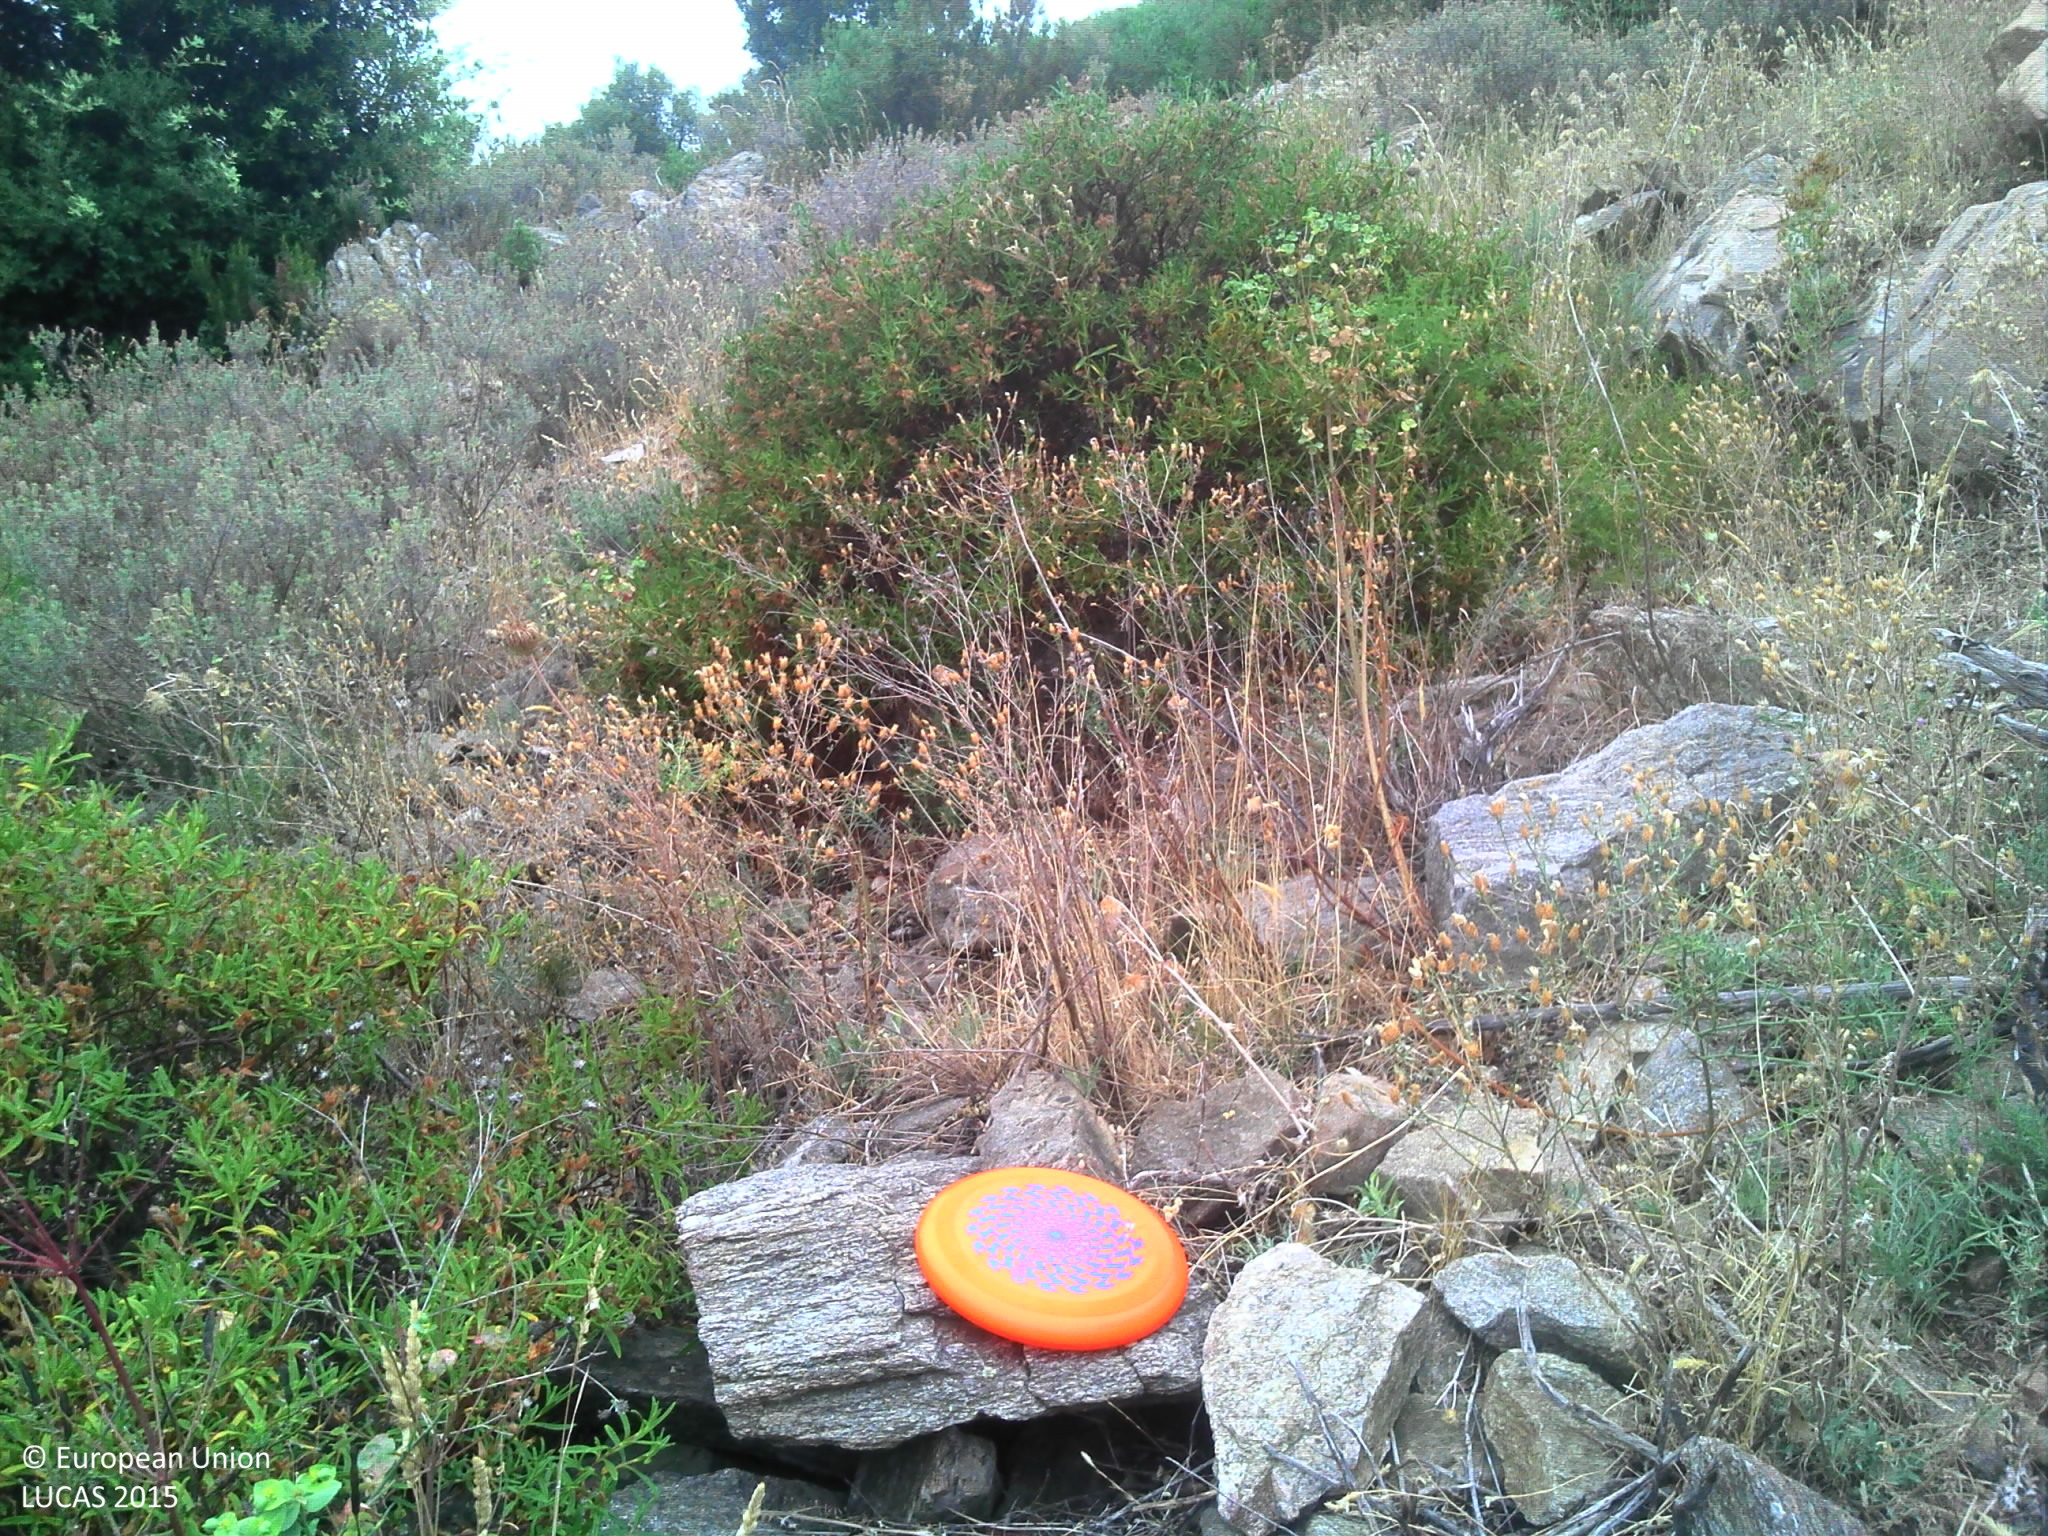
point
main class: Shrubland
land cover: Shrubland without tree cover
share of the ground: > 75 %
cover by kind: shrubs 80 %, unconsolidated bare surface 20 %
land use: Semi-natural and natural areas not in use
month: July
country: FR
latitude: 43.2956
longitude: 6.4222
